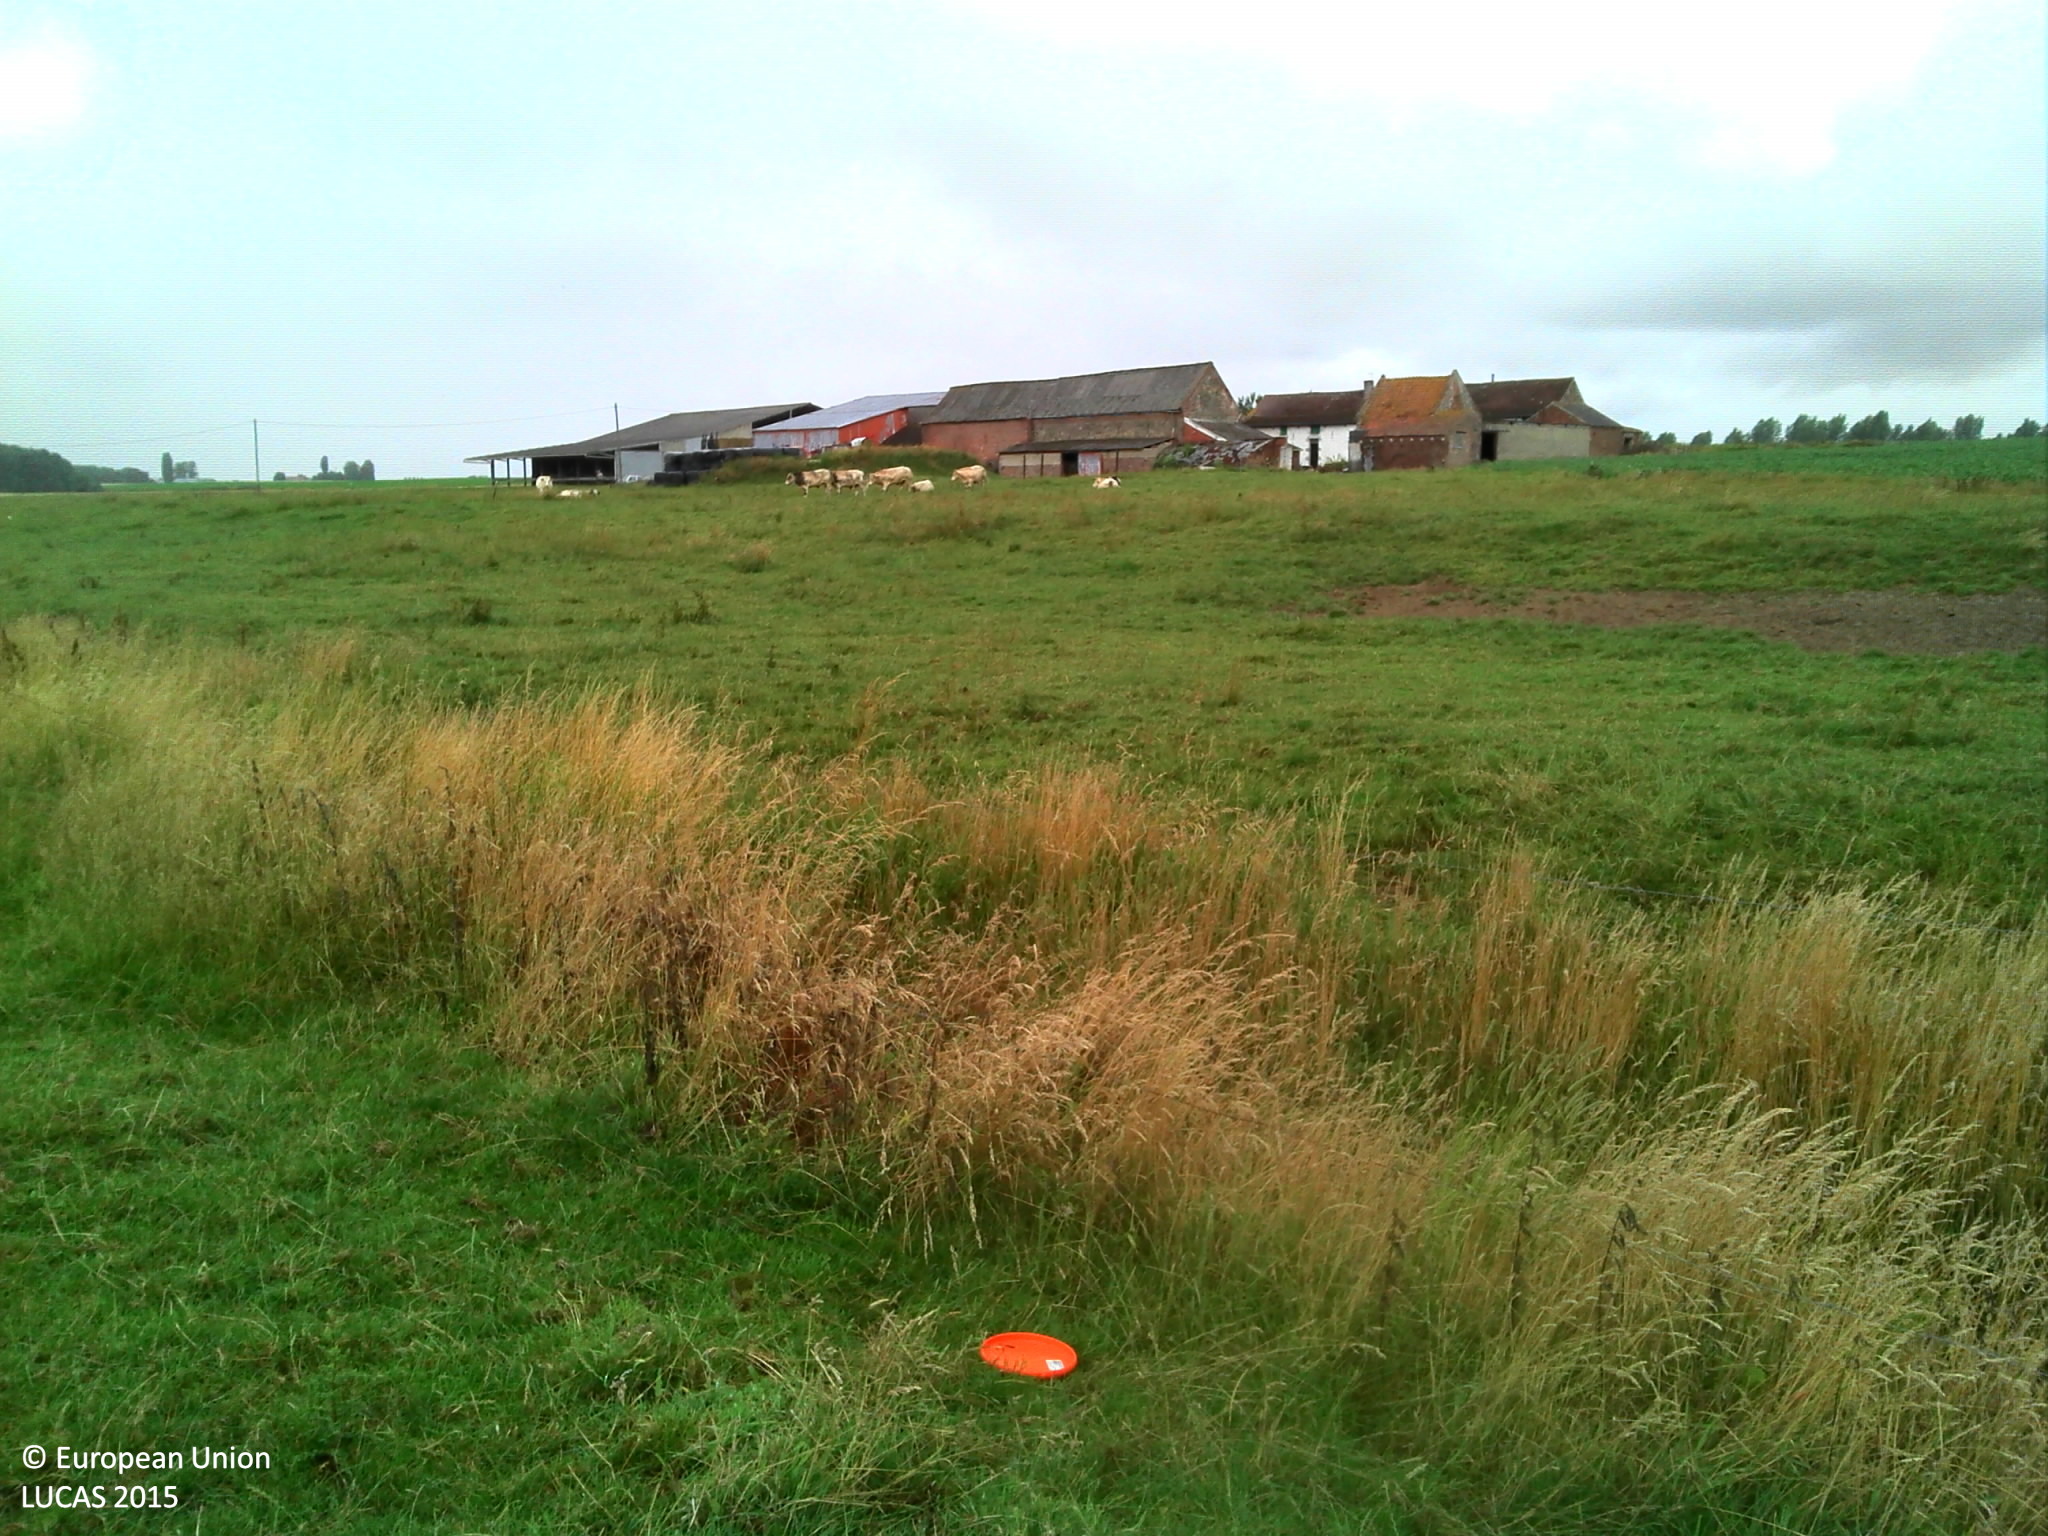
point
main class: Grassland
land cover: Grassland without tree/shrub cover
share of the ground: > 75 %
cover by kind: herbaceous plants 100 %
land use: Agriculture (excluding fallow land and kitchen gardens)
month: July
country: BE
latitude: 50.3563
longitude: 4.1053
